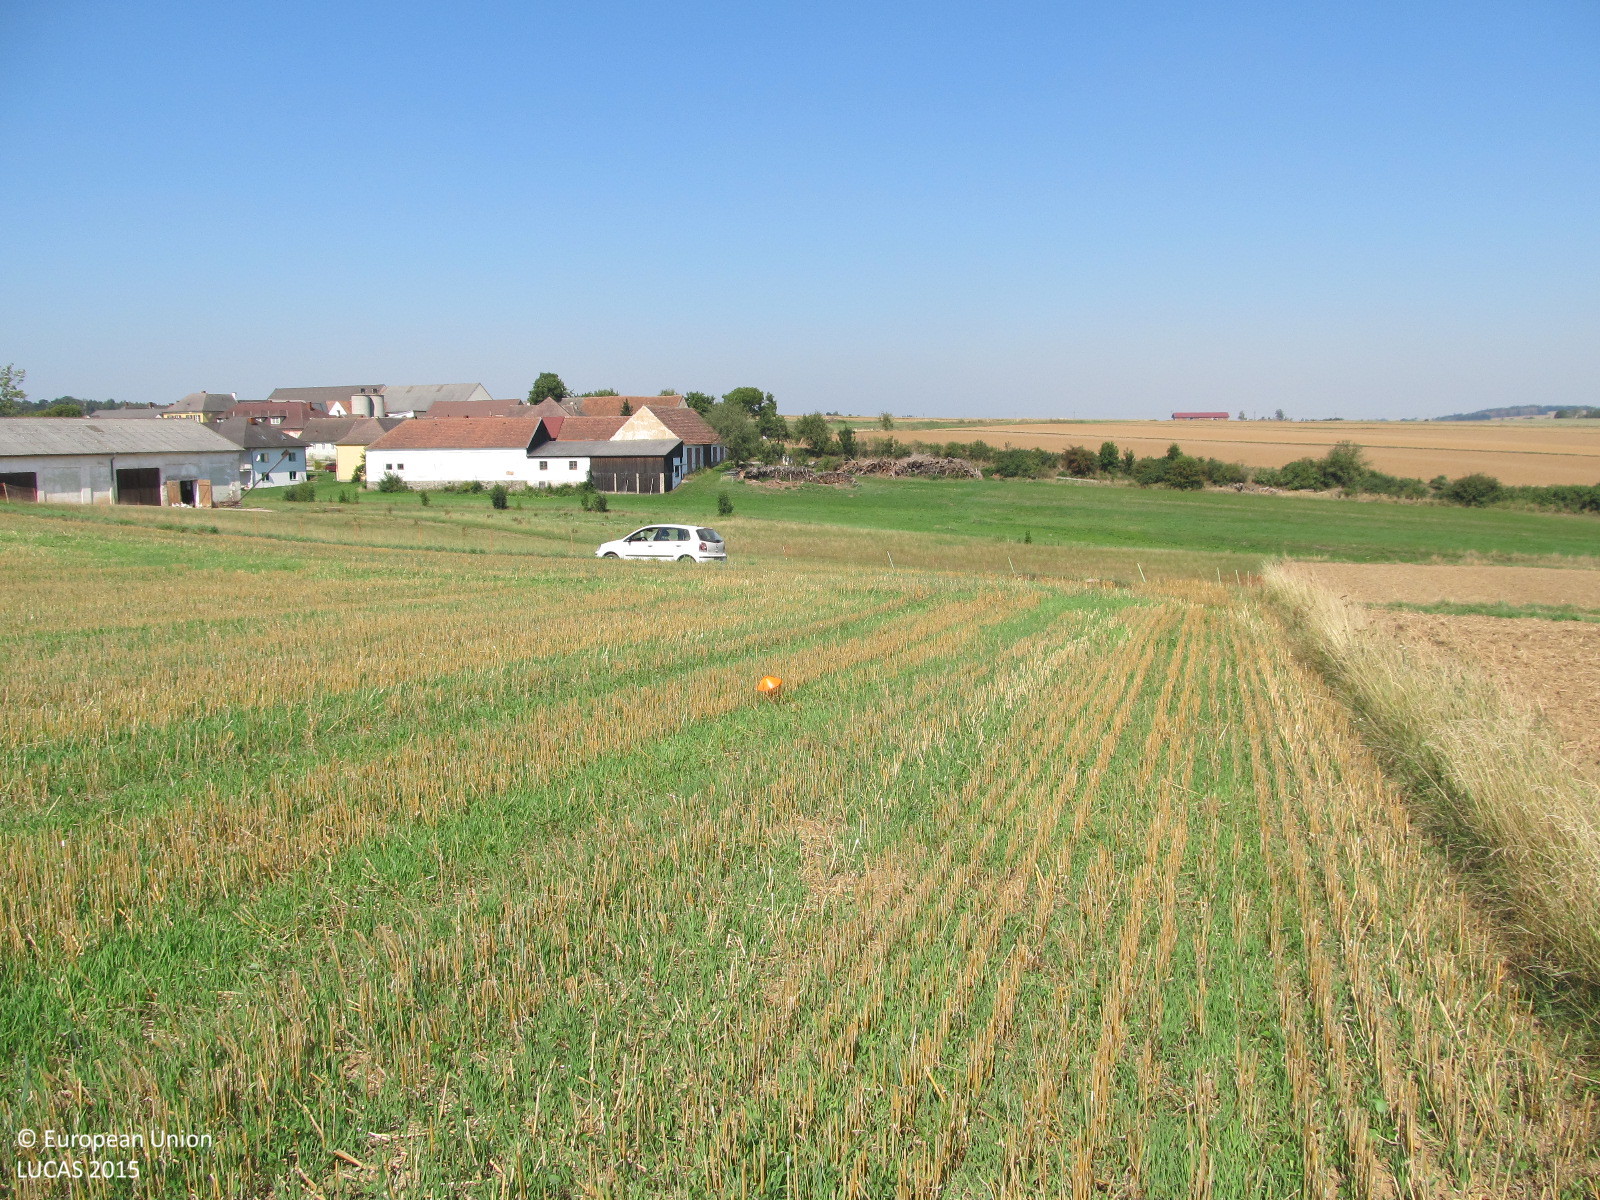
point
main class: Cropland
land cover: Common wheat
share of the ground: 50 - 75 %
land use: Agriculture (excluding fallow land and kitchen gardens)
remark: Harvested field
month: August
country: AT
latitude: 48.8260
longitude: 15.4926
